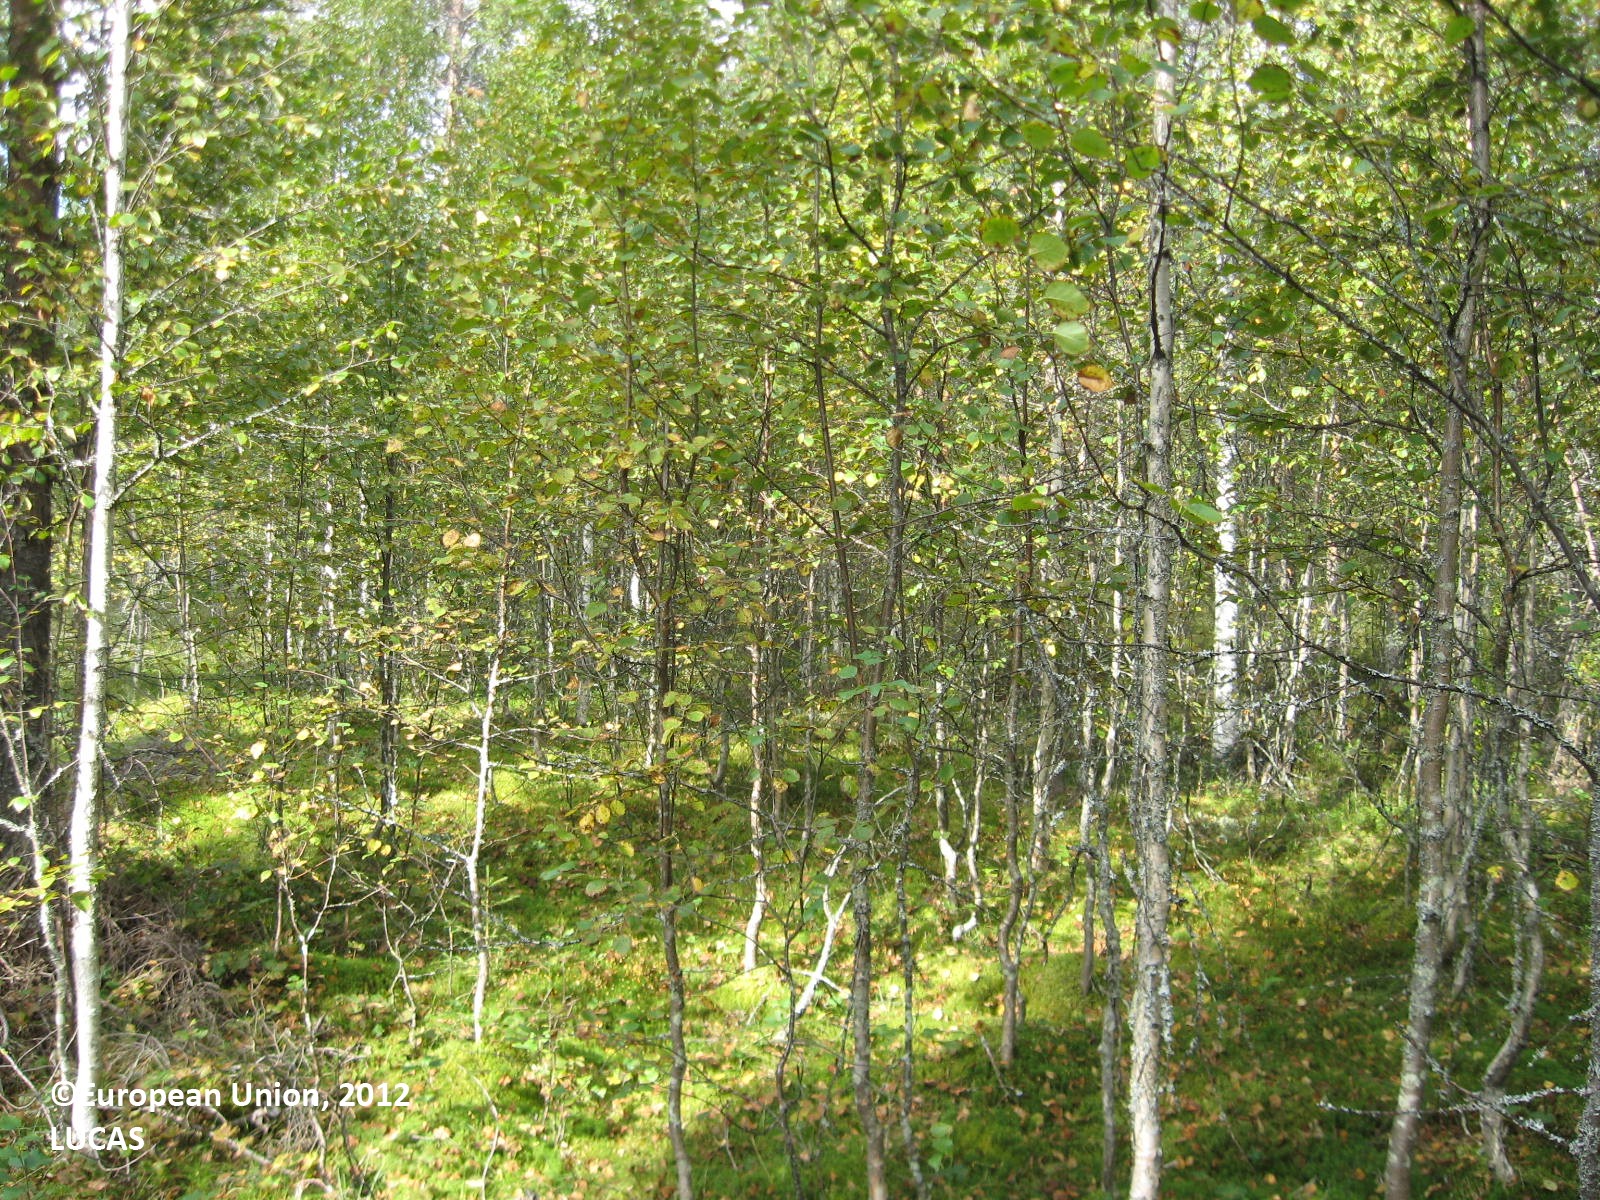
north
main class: Woodland
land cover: Other coniferous woodland
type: boreal forest
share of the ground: > 75 %
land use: Forestry
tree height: > 5 m
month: August
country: FI
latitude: 63.8155
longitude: 29.1186
